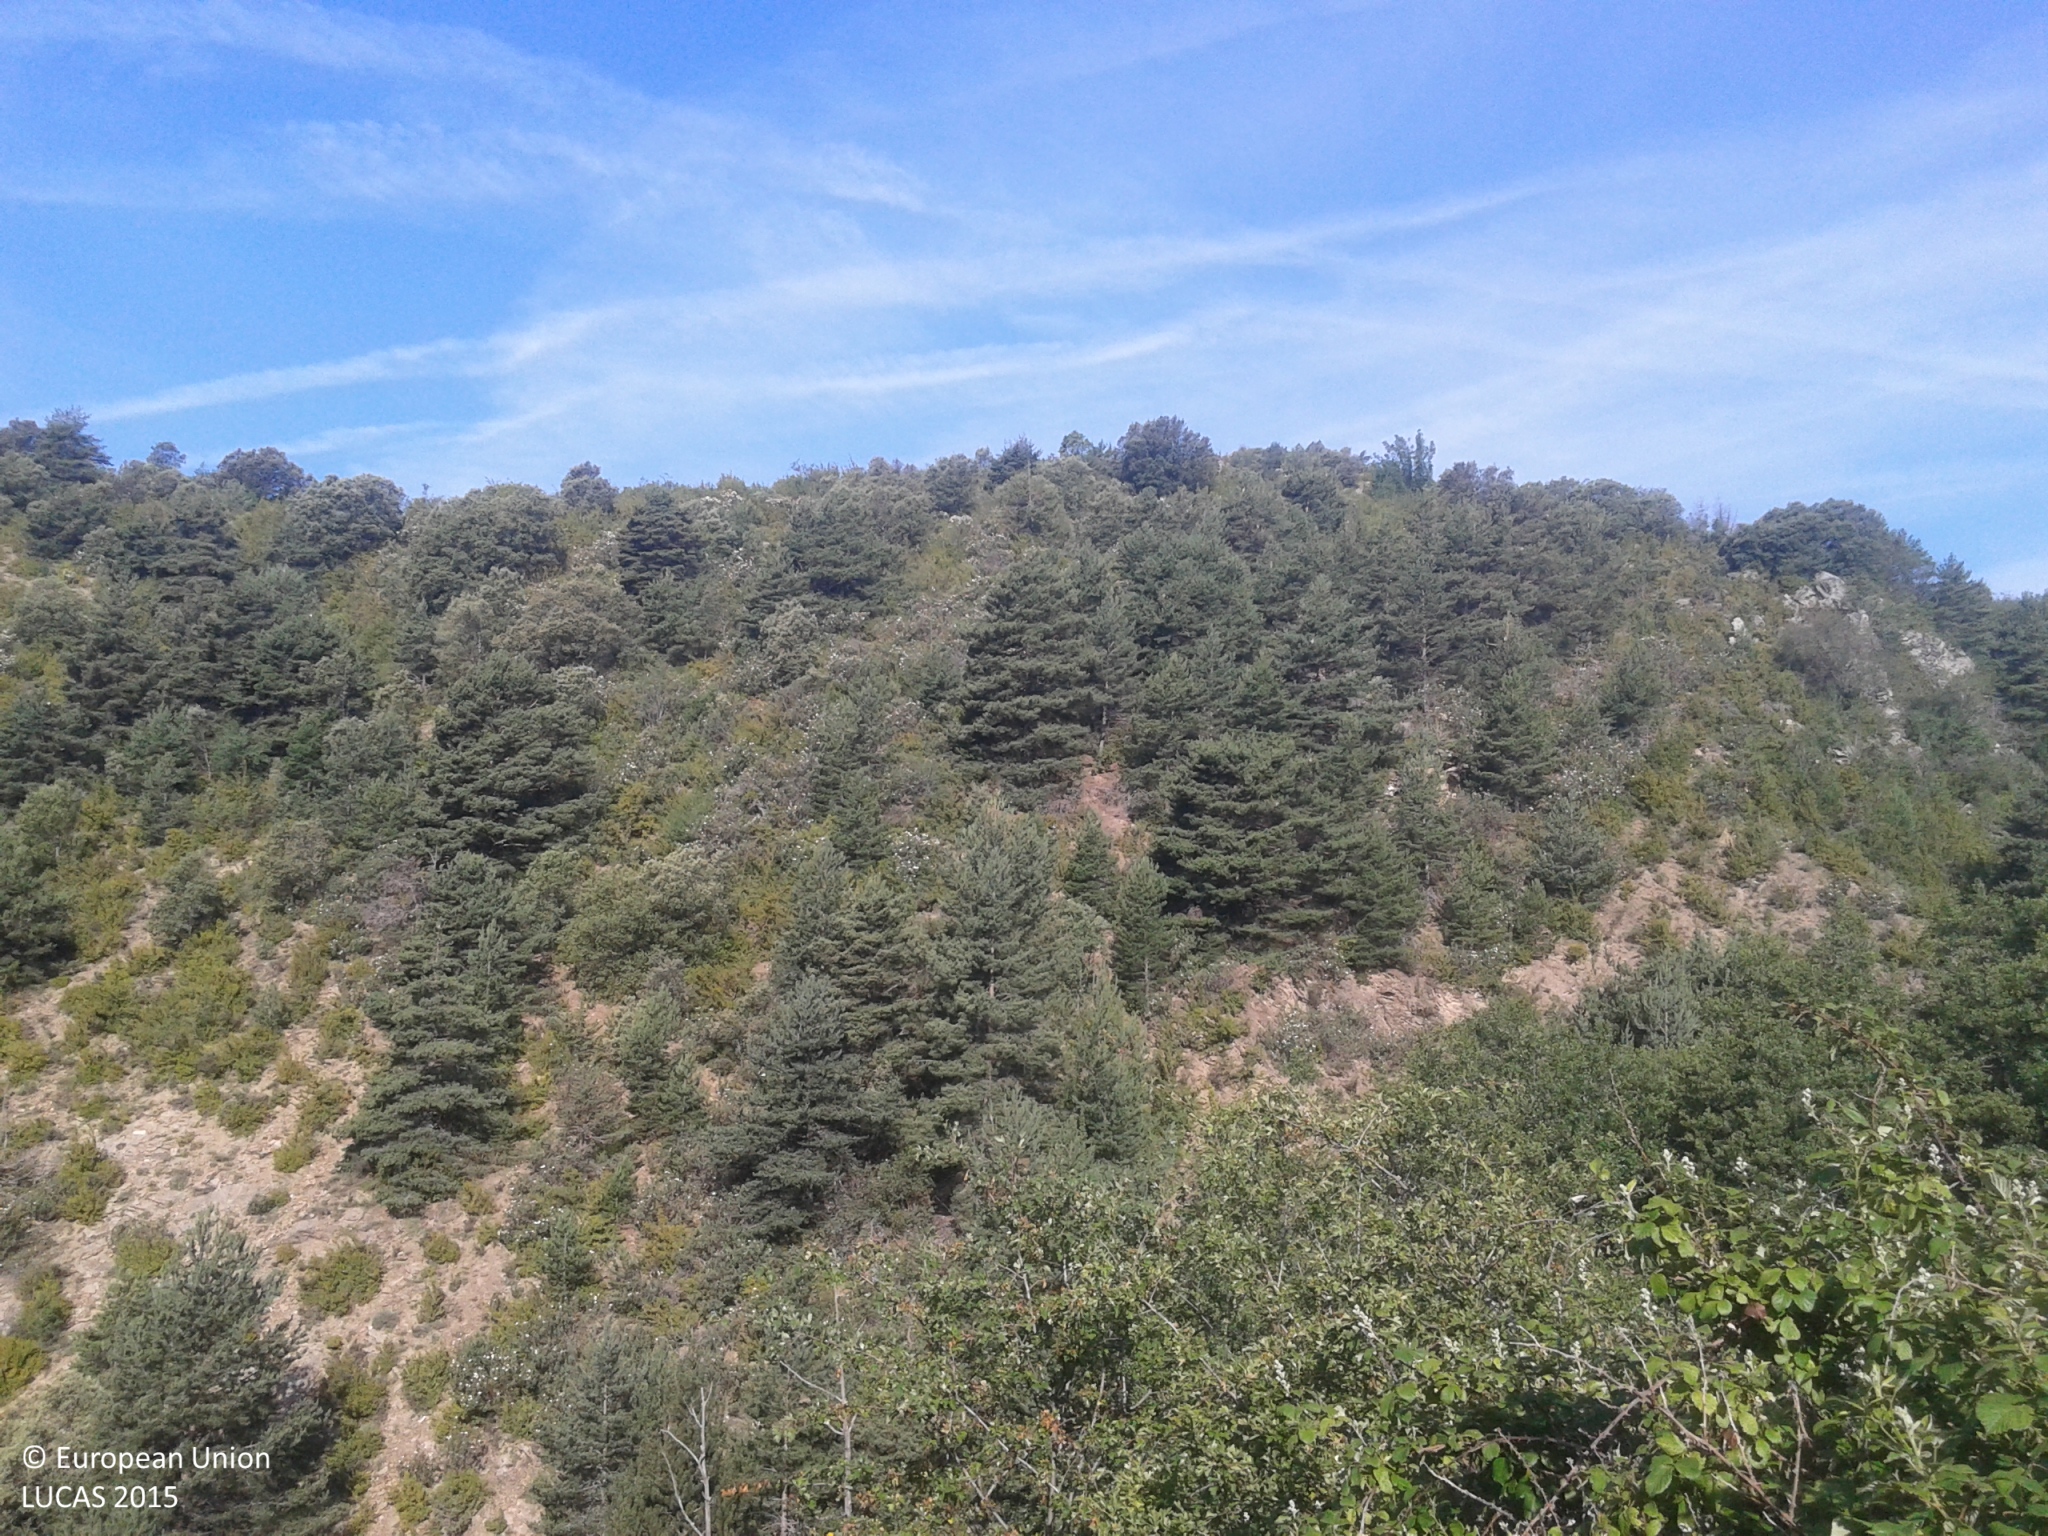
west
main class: Woodland
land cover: Pine dominated coniferous woodland
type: alpine coniferous forest
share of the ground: 25 - 50 %
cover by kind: shrubs 50 %, coniferous forest trees 30 %, unconsolidated bare surface 10 %, herbaceous plants 5 %, consolidated bare surface 5 %
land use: Semi-natural and natural areas not in use
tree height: > 5 m
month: June
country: ES
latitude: 42.3886
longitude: 1.5193
